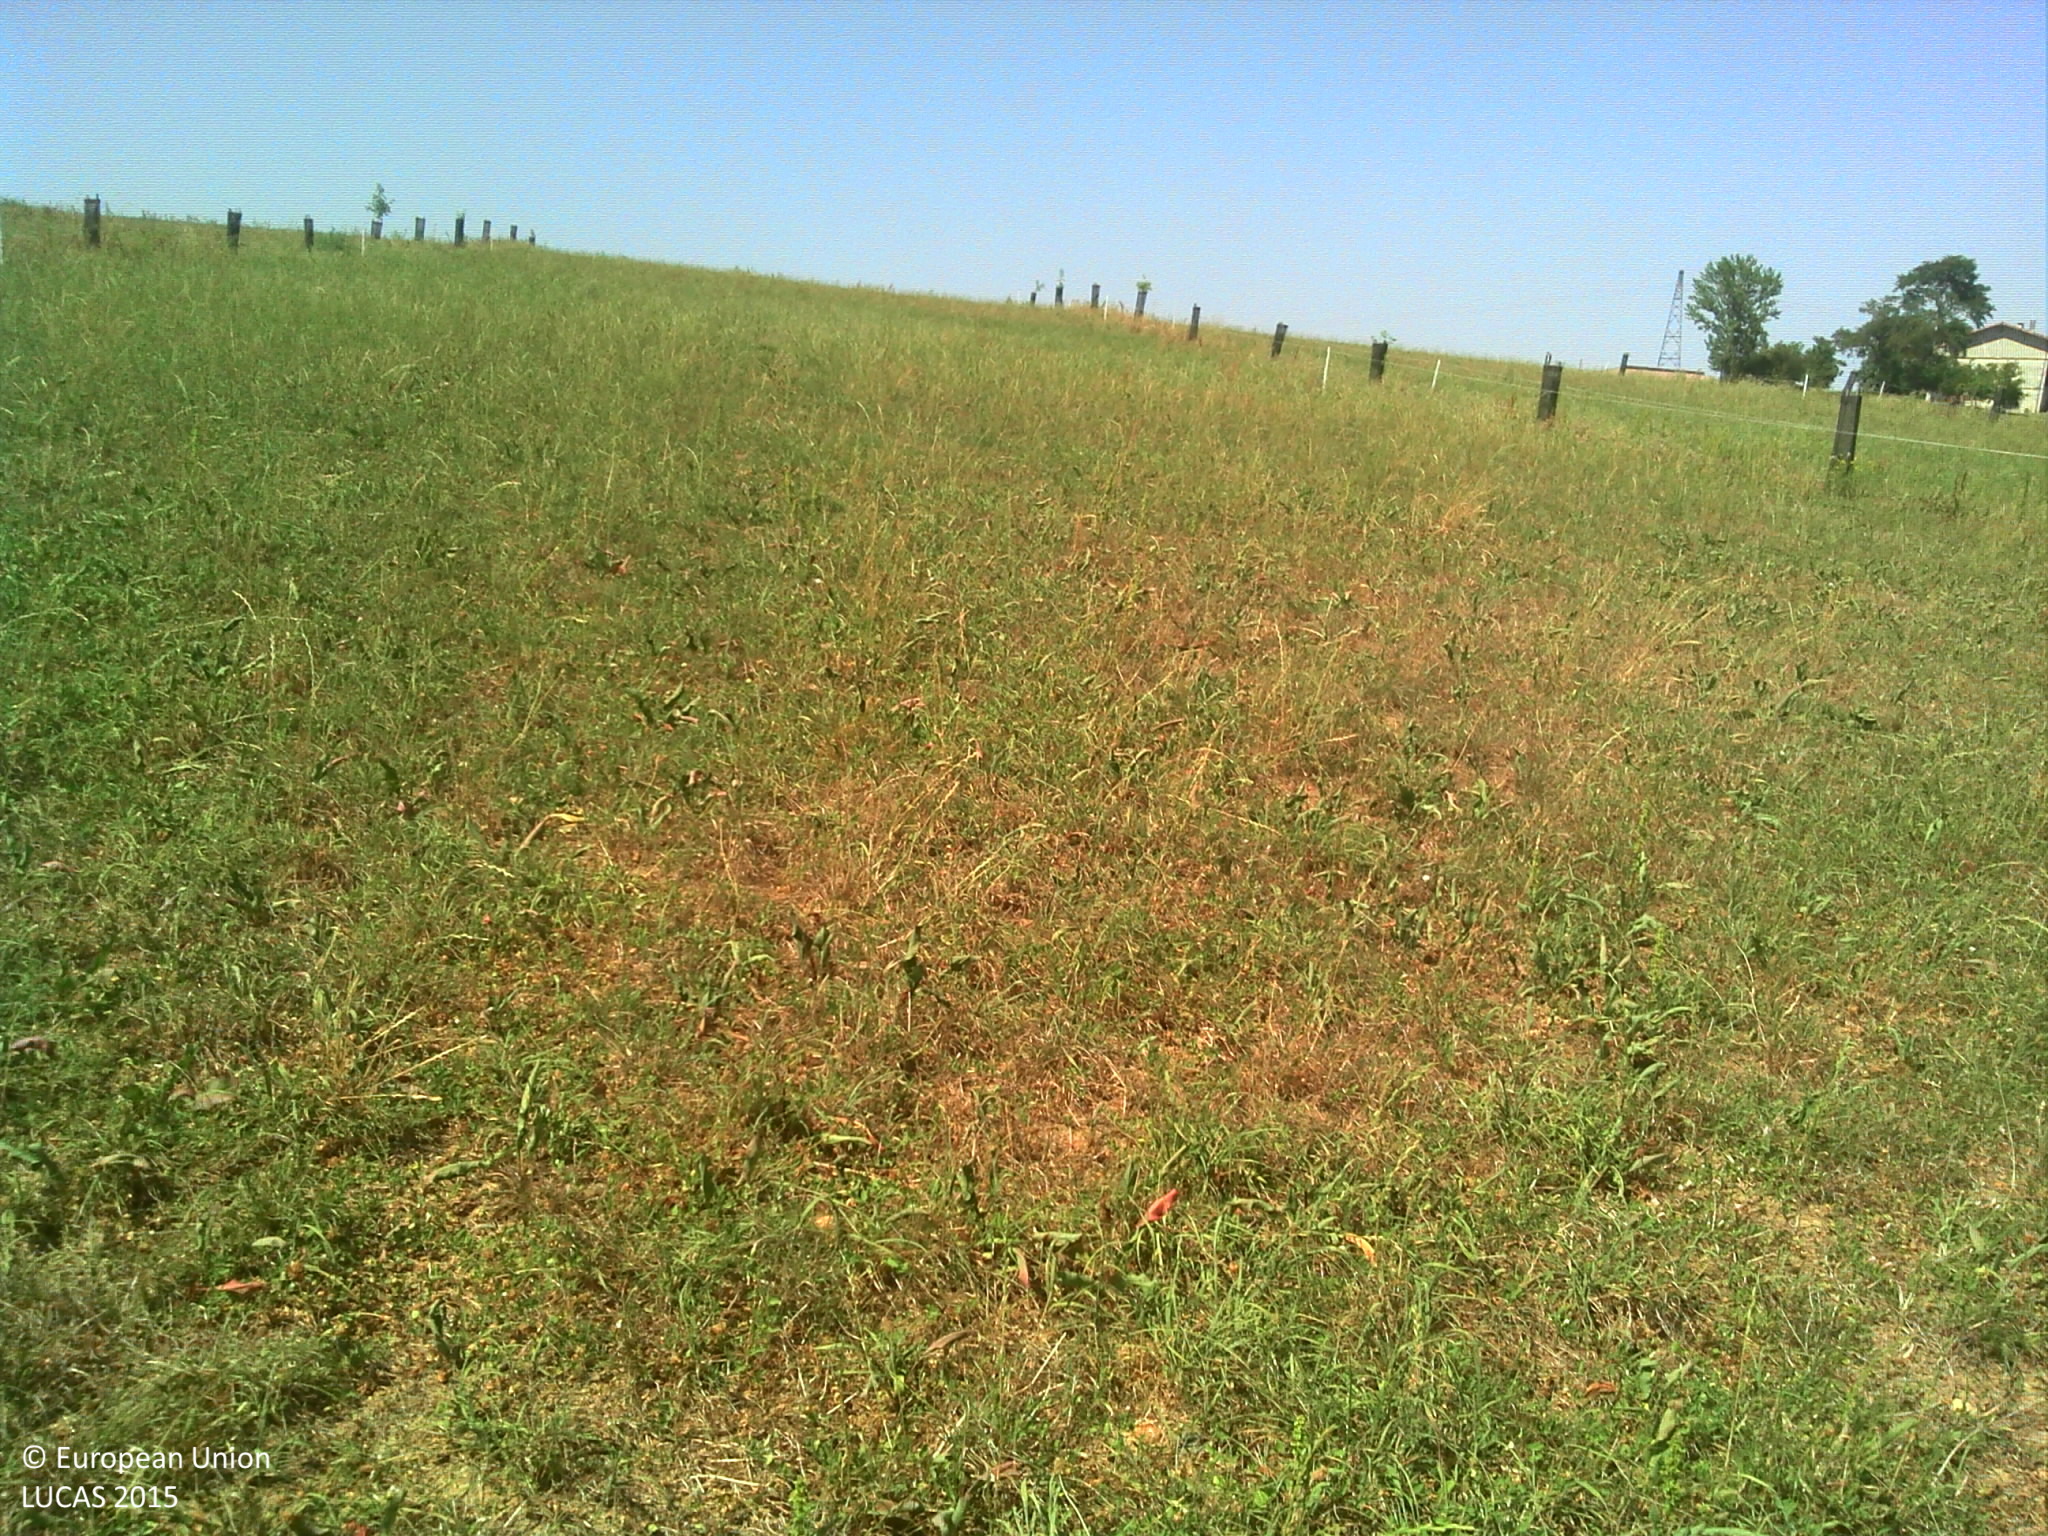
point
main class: Grassland
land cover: Grassland without tree/shrub cover
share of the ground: > 75 %
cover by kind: herbaceous plants 100 %
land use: Agriculture (excluding fallow land and kitchen gardens)
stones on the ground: 10 - 25 %
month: July
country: FR
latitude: 44.0115
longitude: 0.9798
